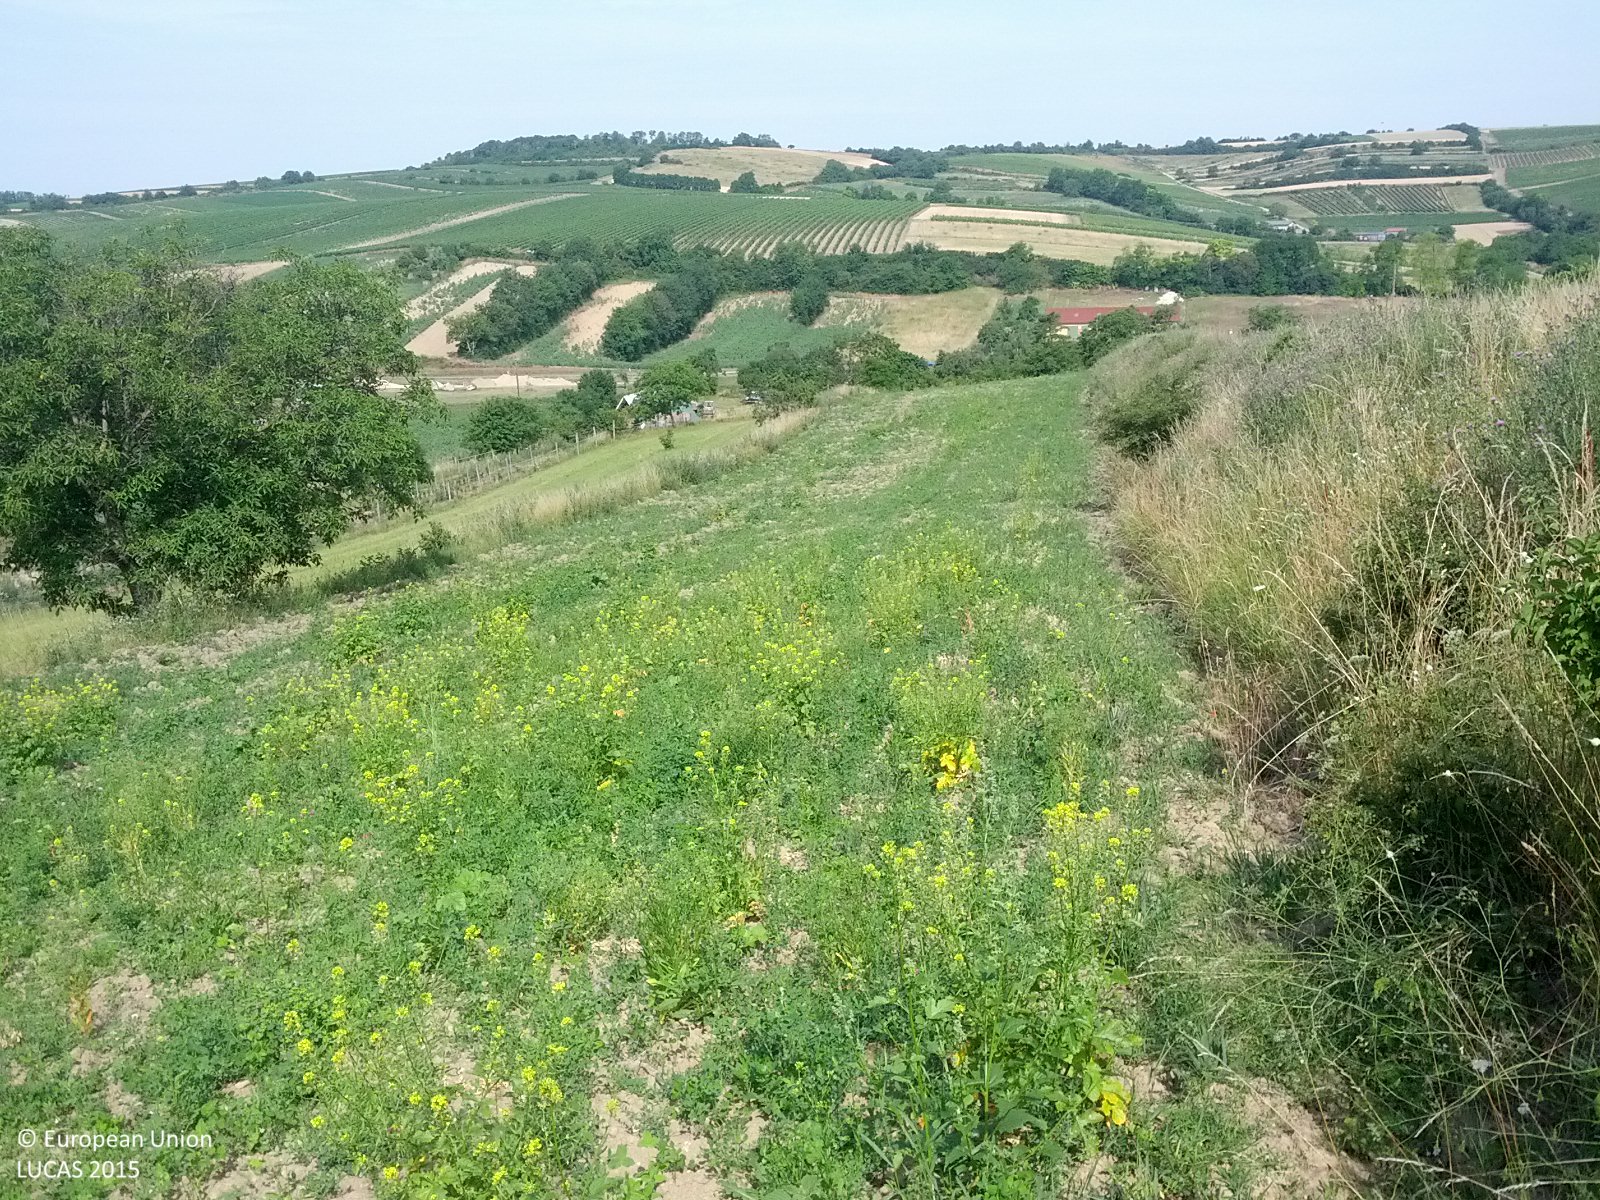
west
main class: Grassland
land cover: Grassland without tree/shrub cover
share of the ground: > 75 %
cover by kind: herbaceous plants 100 %
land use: Agriculture (excluding fallow land and kitchen gardens)
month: June
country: AT
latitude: 48.6890
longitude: 16.6769
